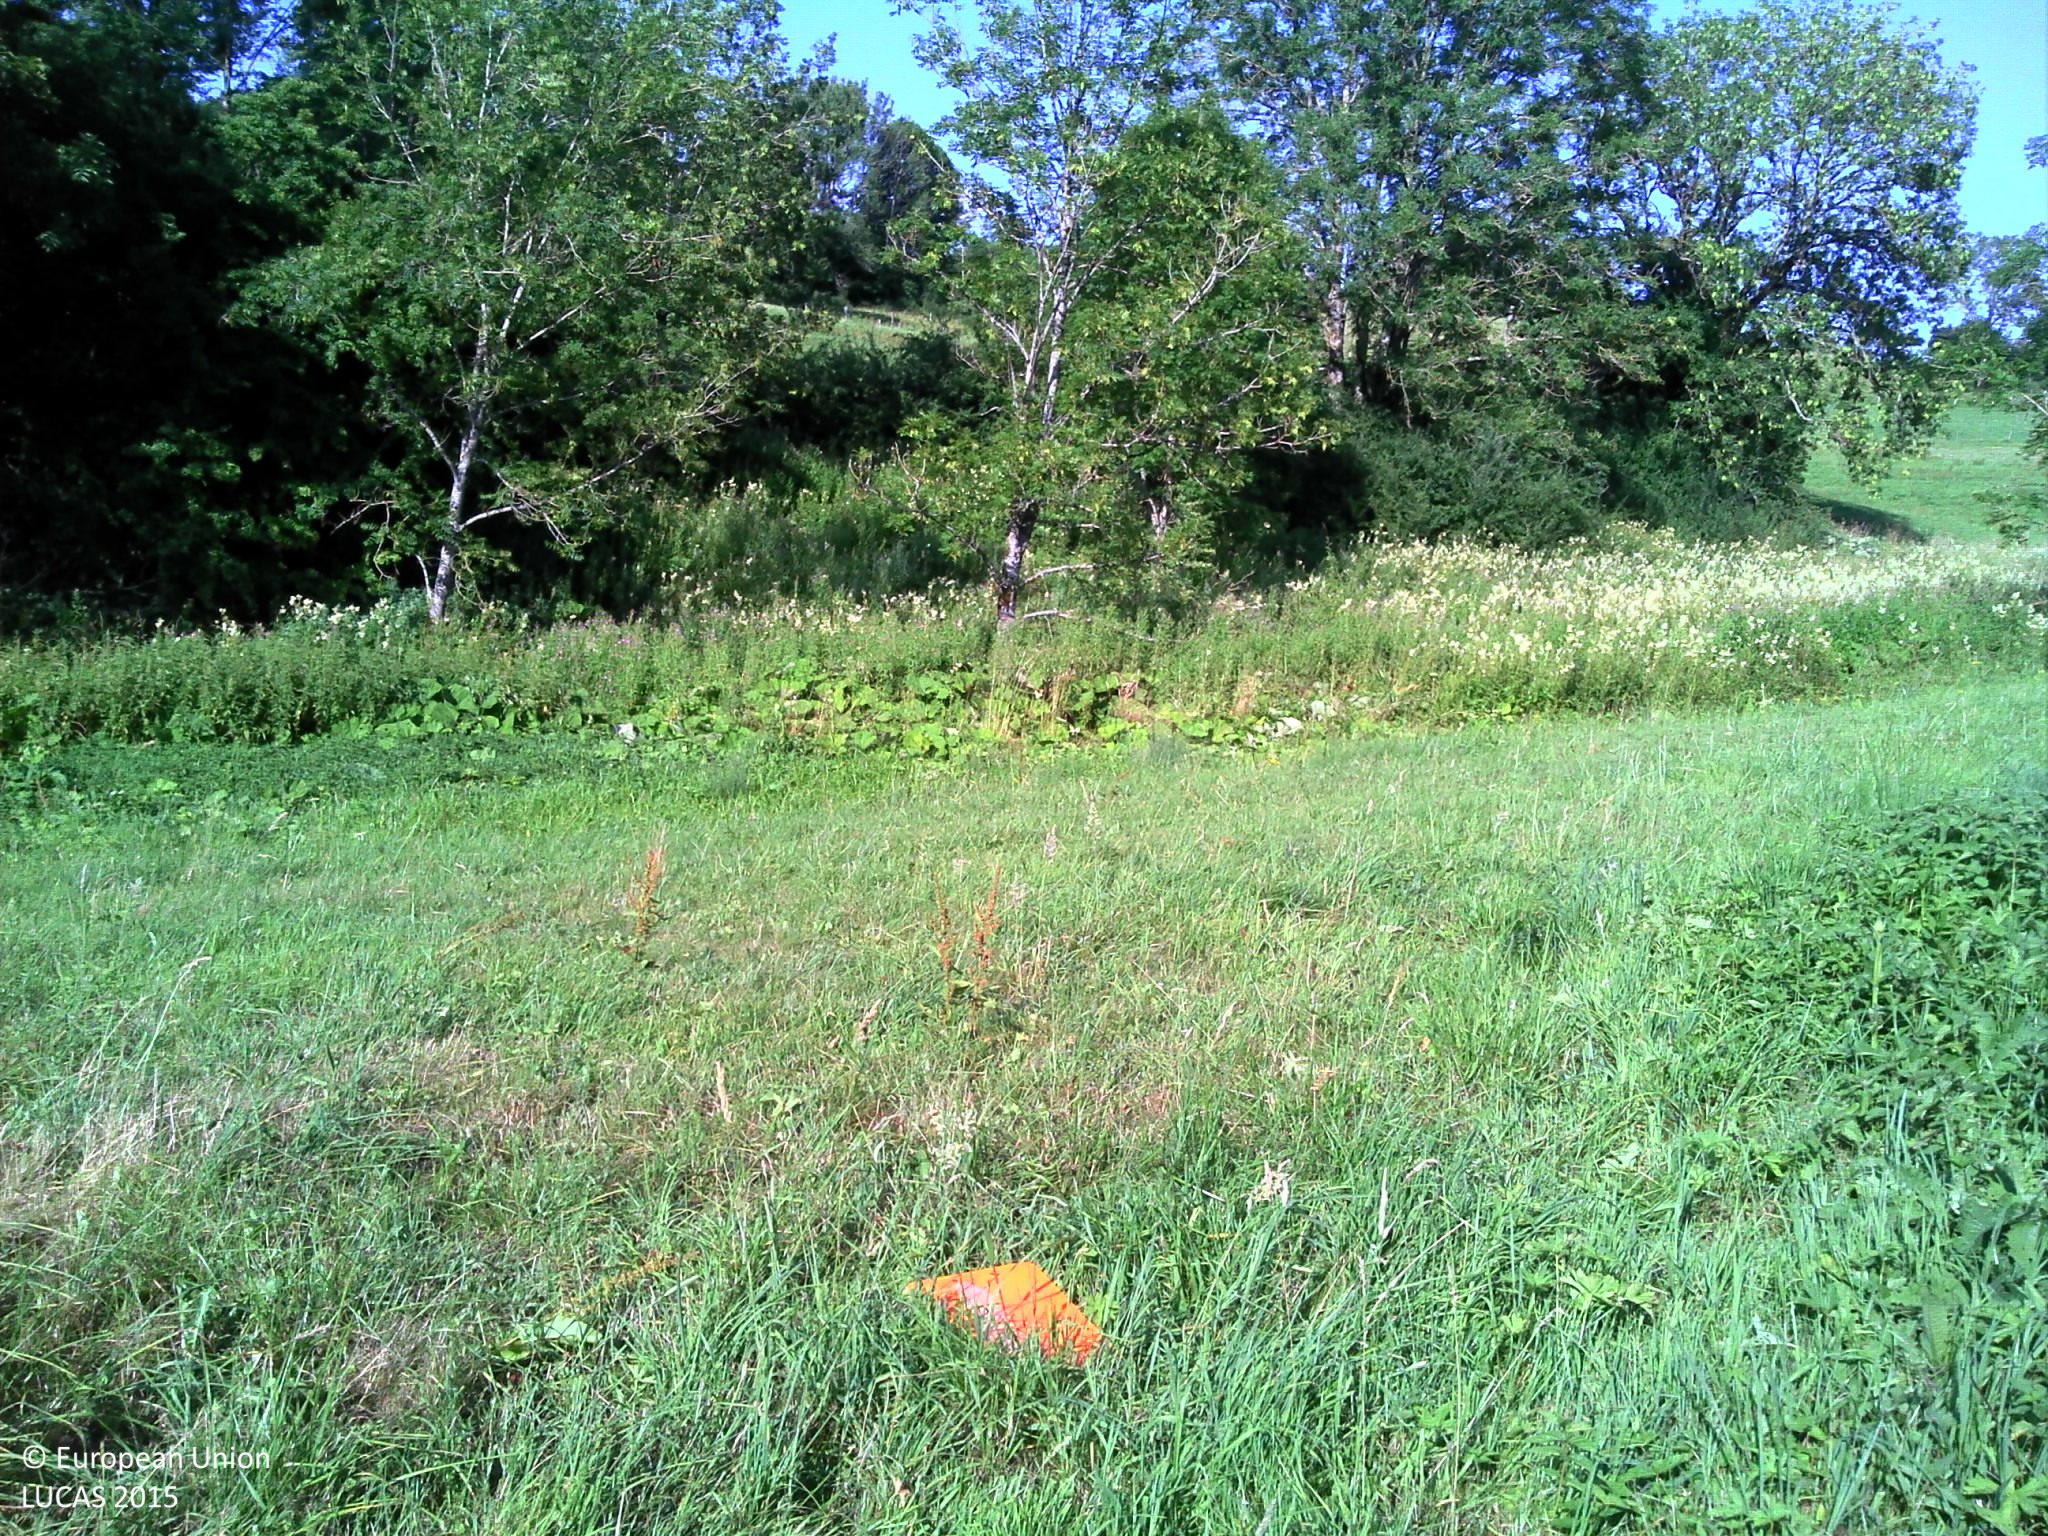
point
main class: Grassland
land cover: Grassland without tree/shrub cover
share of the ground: > 75 %
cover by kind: herbaceous plants 100 %
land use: Agriculture (excluding fallow land and kitchen gardens)
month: July
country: FR
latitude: 46.7845
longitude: 6.0860
